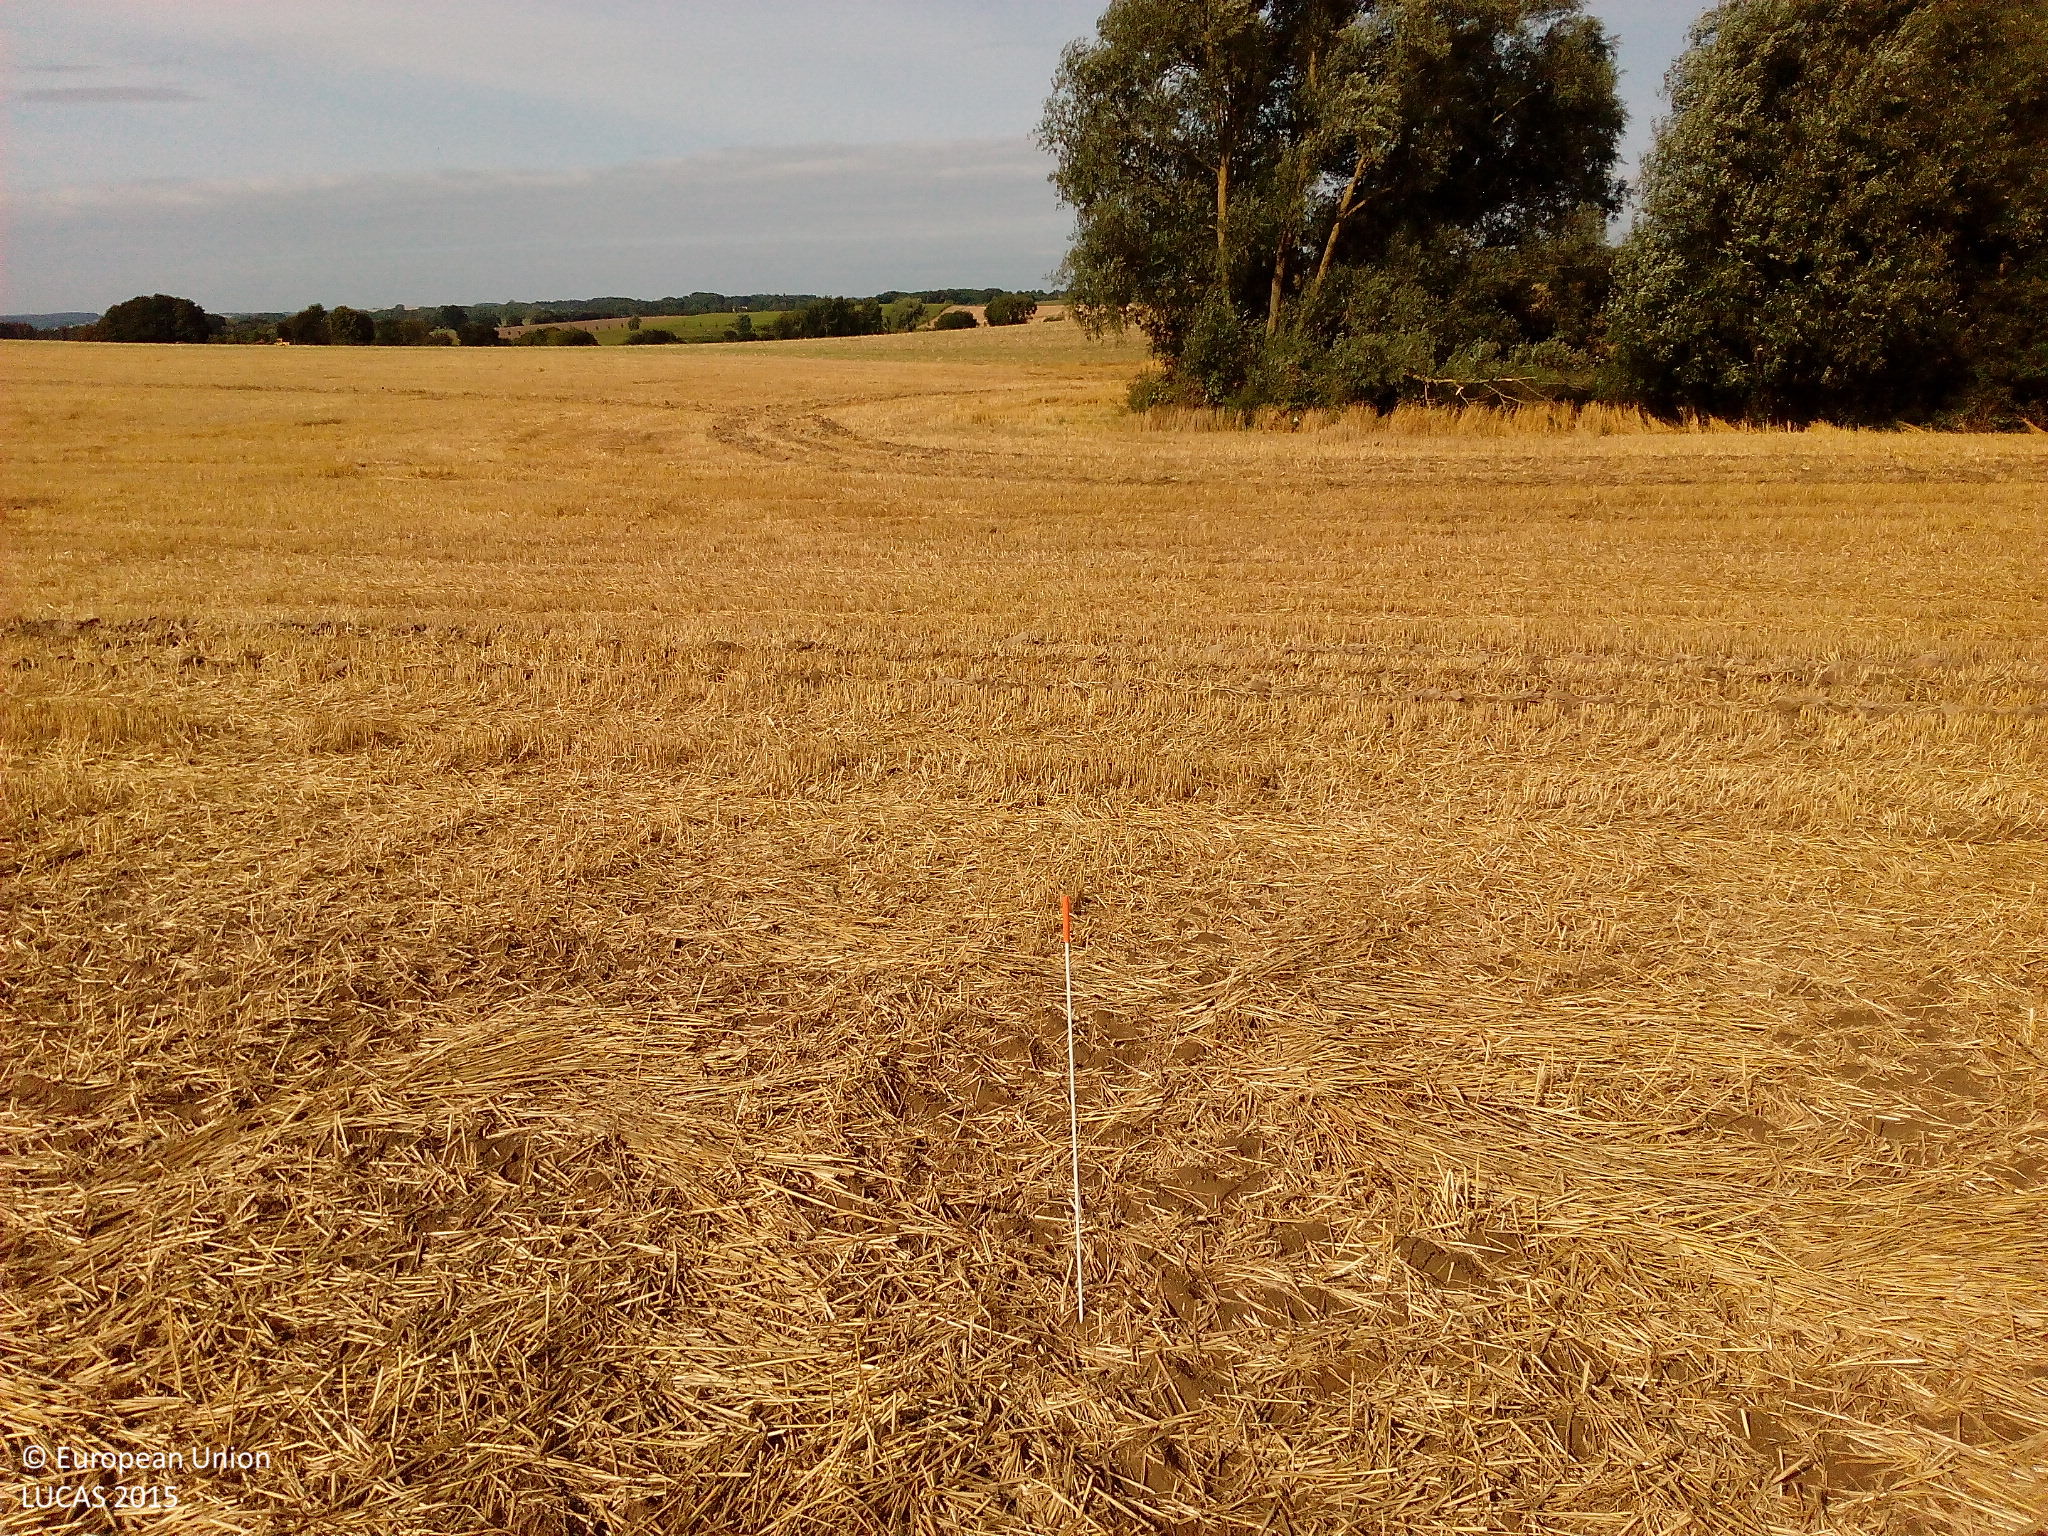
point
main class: Cropland
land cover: Common wheat
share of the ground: 50 - 75 %
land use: Agriculture (excluding fallow land and kitchen gardens)
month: August
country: DE
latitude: 53.8576
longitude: 12.6903
